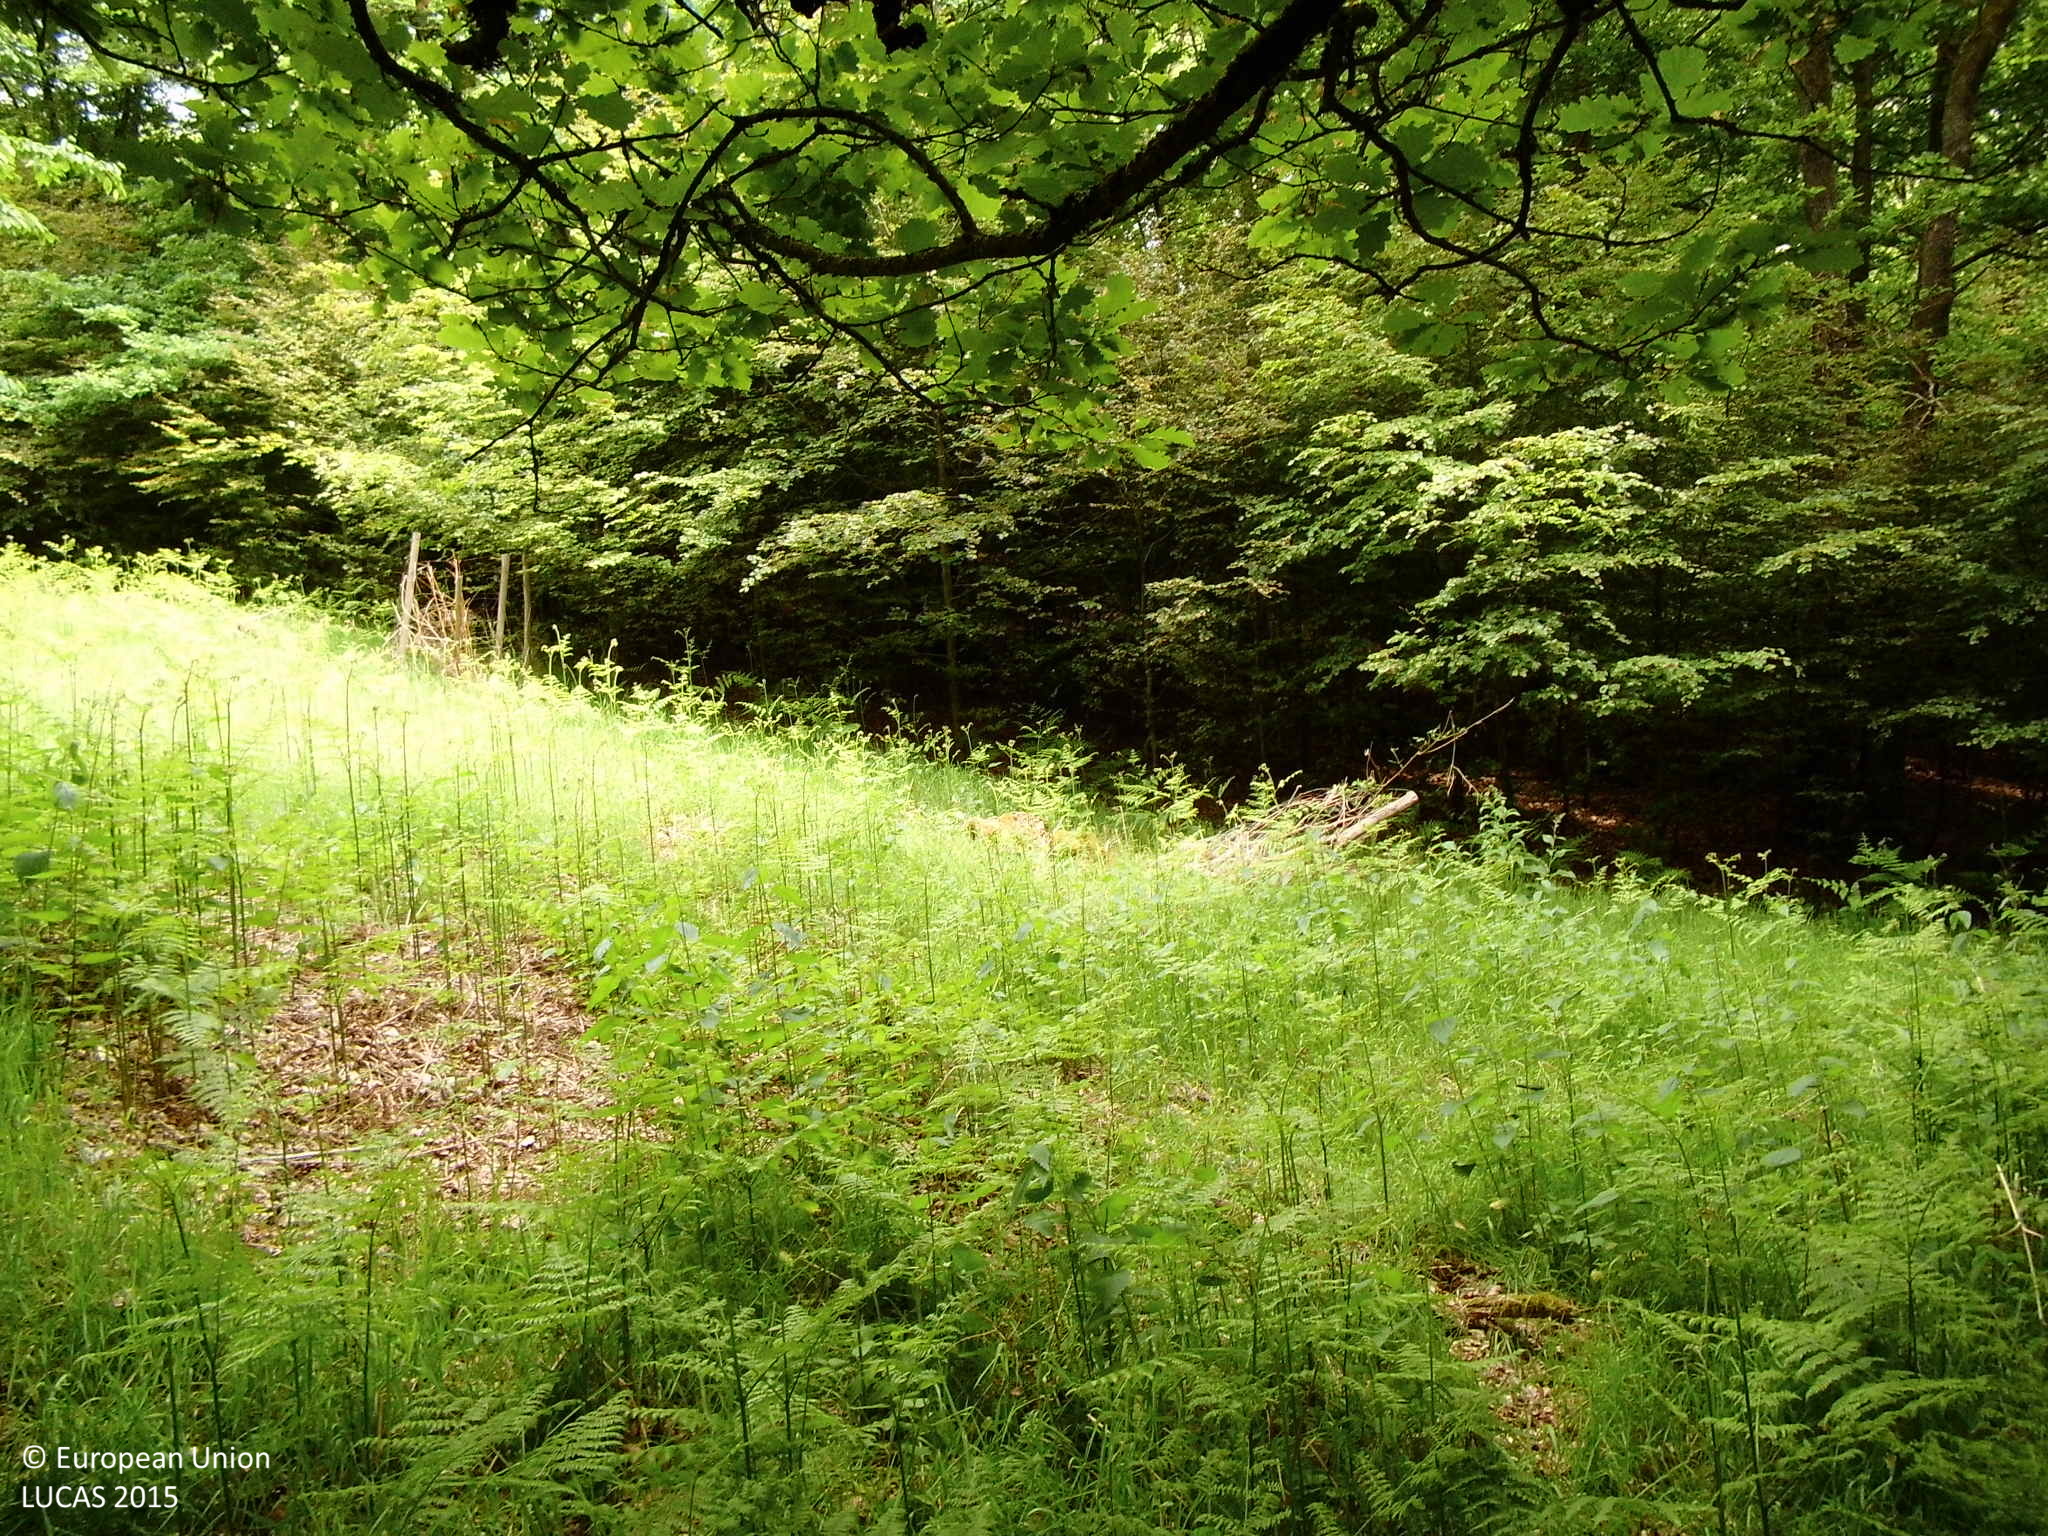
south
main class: Woodland
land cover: Broadleaved woodland
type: mesophytic deciduous forest
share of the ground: > 75 %
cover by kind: broadleaved forest trees 80 %, herbaceous plants 20 %
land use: Forestry
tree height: > 5 m
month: June
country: DE
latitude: 50.7981
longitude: 8.1133
